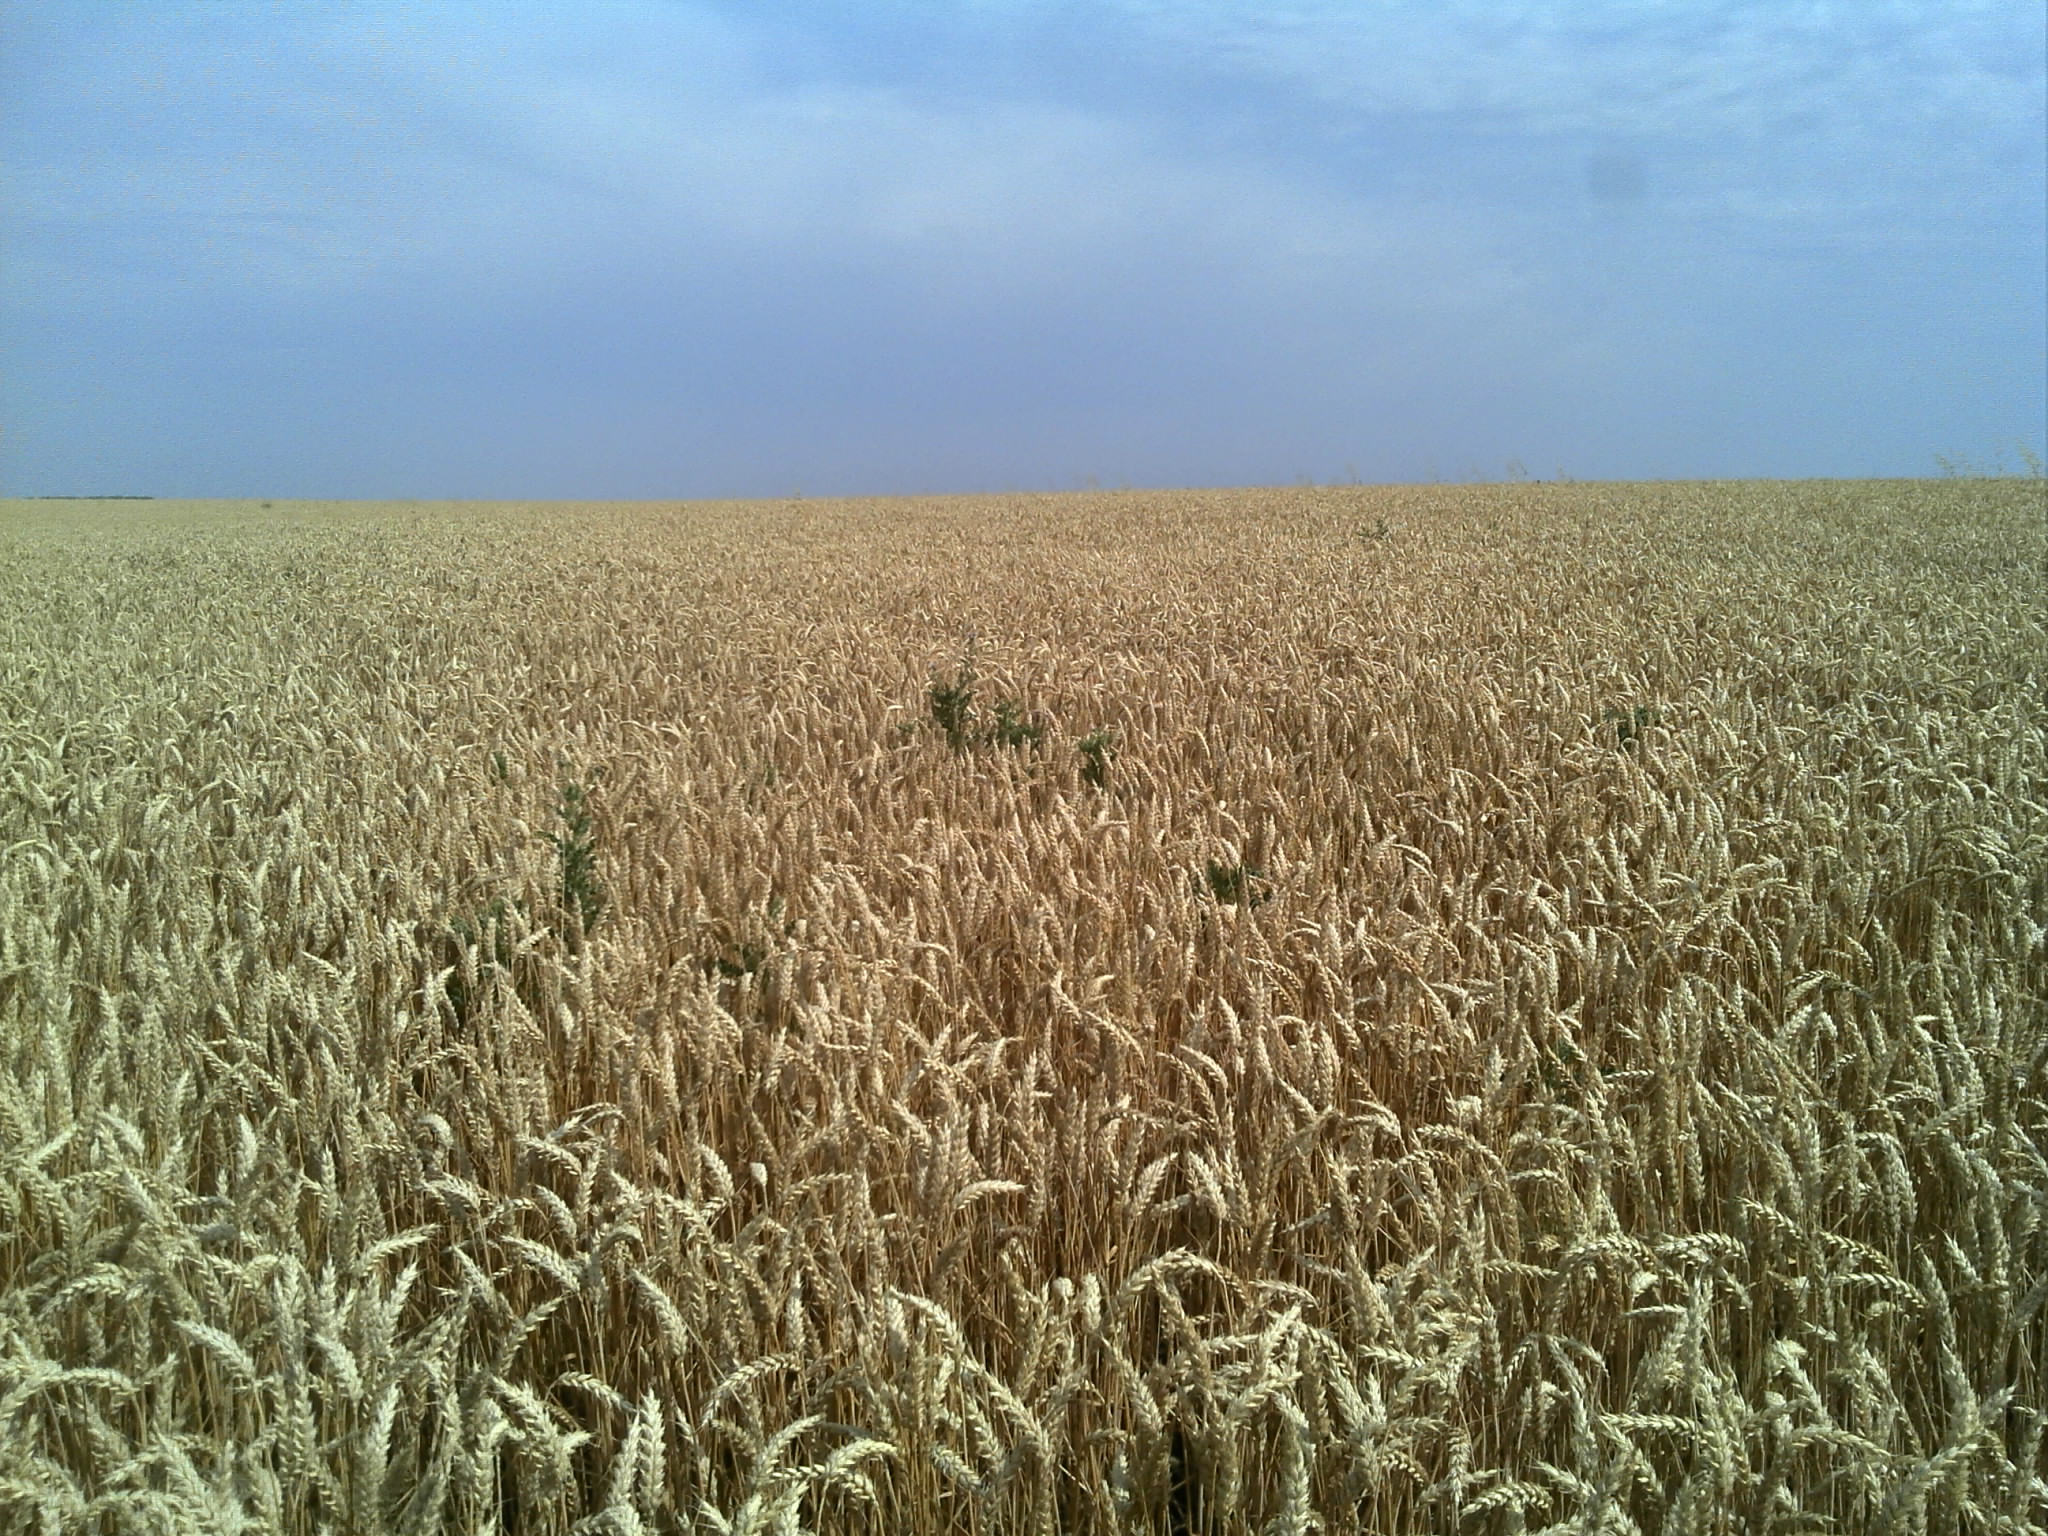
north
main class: Cropland
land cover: Common wheat
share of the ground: > 75 %
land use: Agriculture (excluding fallow land and kitchen gardens)
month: July
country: FR
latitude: 46.9129
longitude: 2.1535
